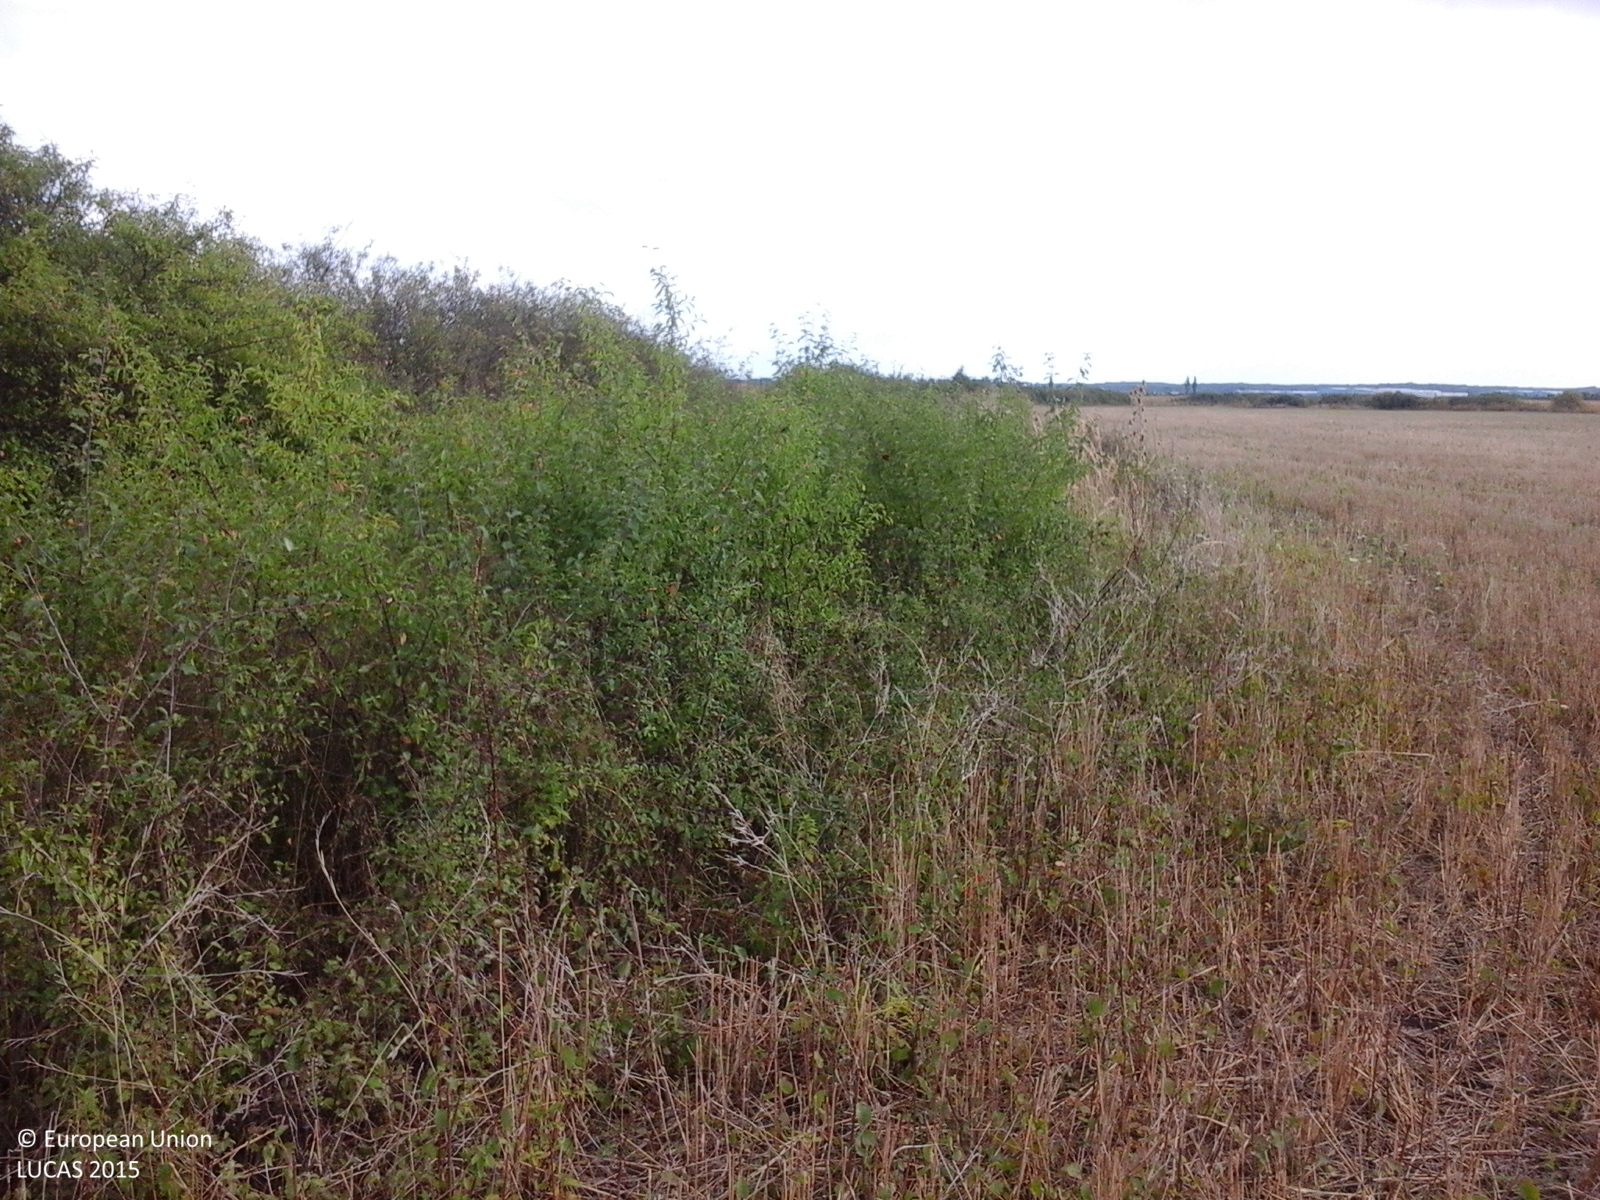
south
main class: Cropland
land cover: Common wheat
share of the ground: 50 - 75 %
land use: Agriculture (excluding fallow land and kitchen gardens)
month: August
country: RO
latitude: 45.7977
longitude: 21.3670
